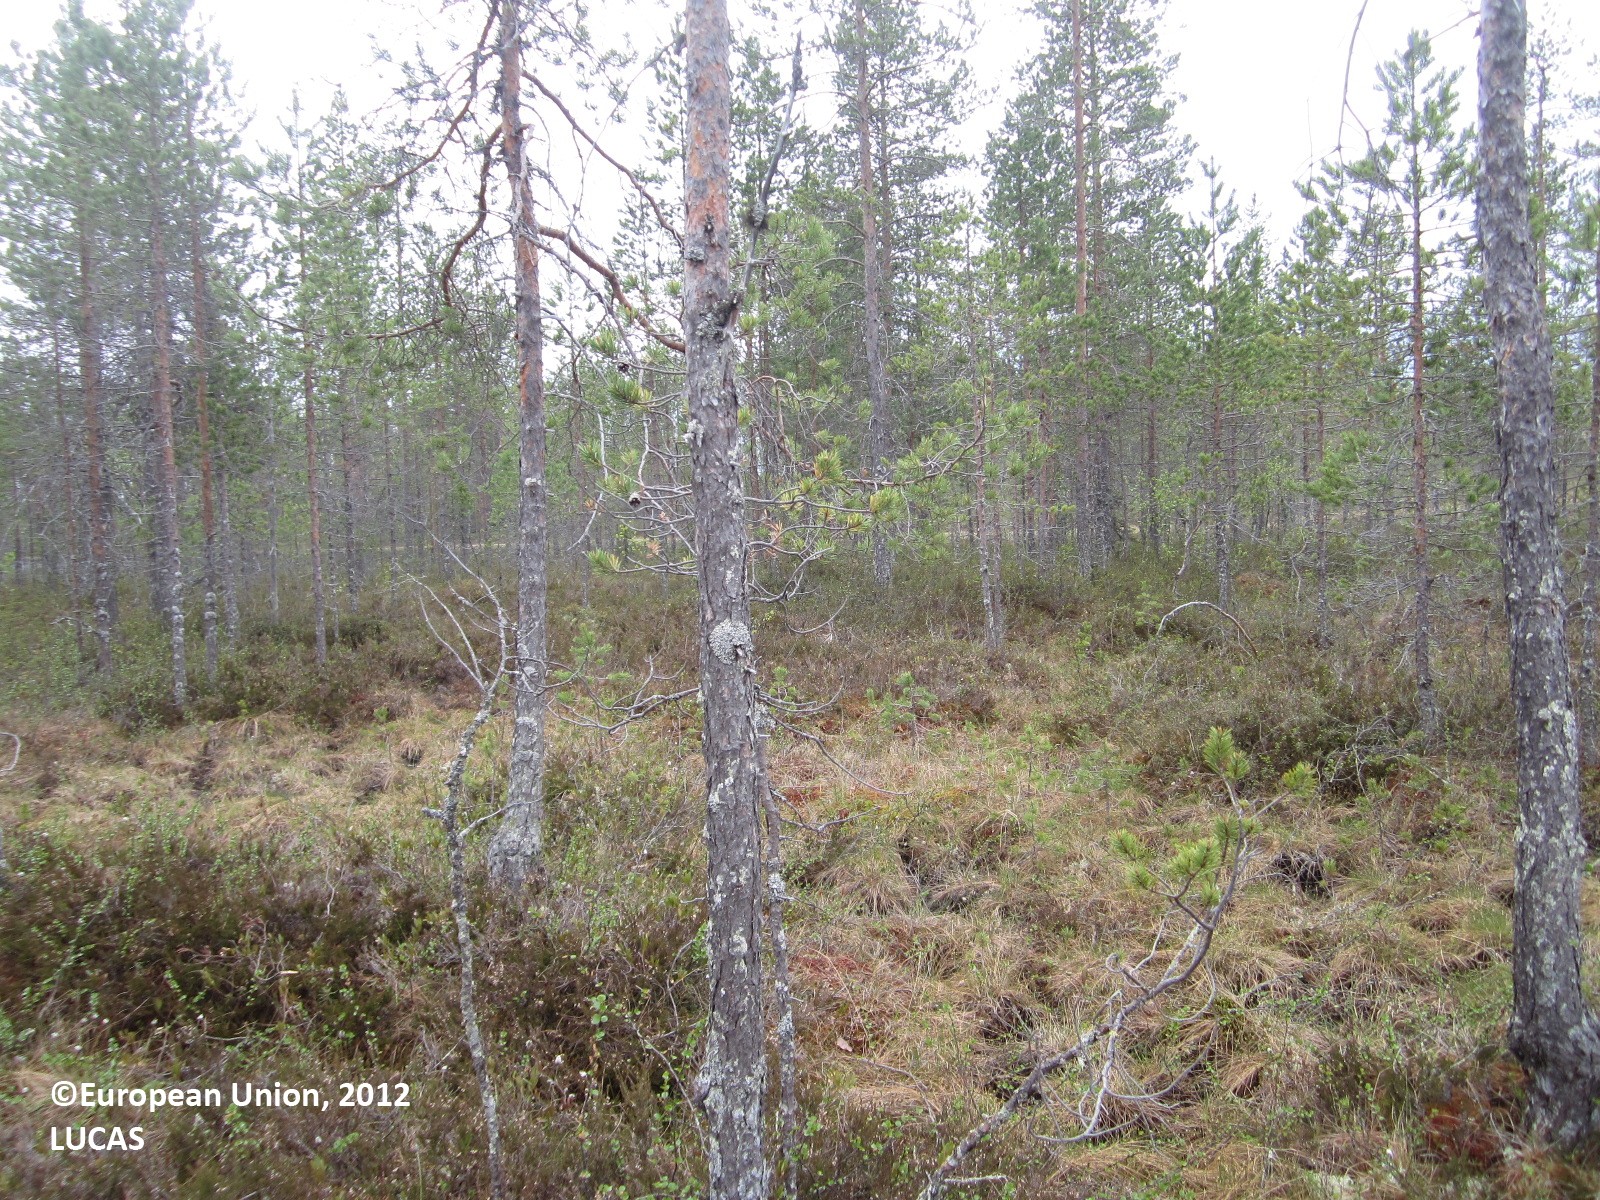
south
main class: Woodland
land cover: Pine dominated coniferous woodland
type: mire and swamp forests
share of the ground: 10 - 25 %
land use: Semi-natural and natural areas not in use
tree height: > 5 m
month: June
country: FI
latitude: 64.6834
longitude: 28.6000
